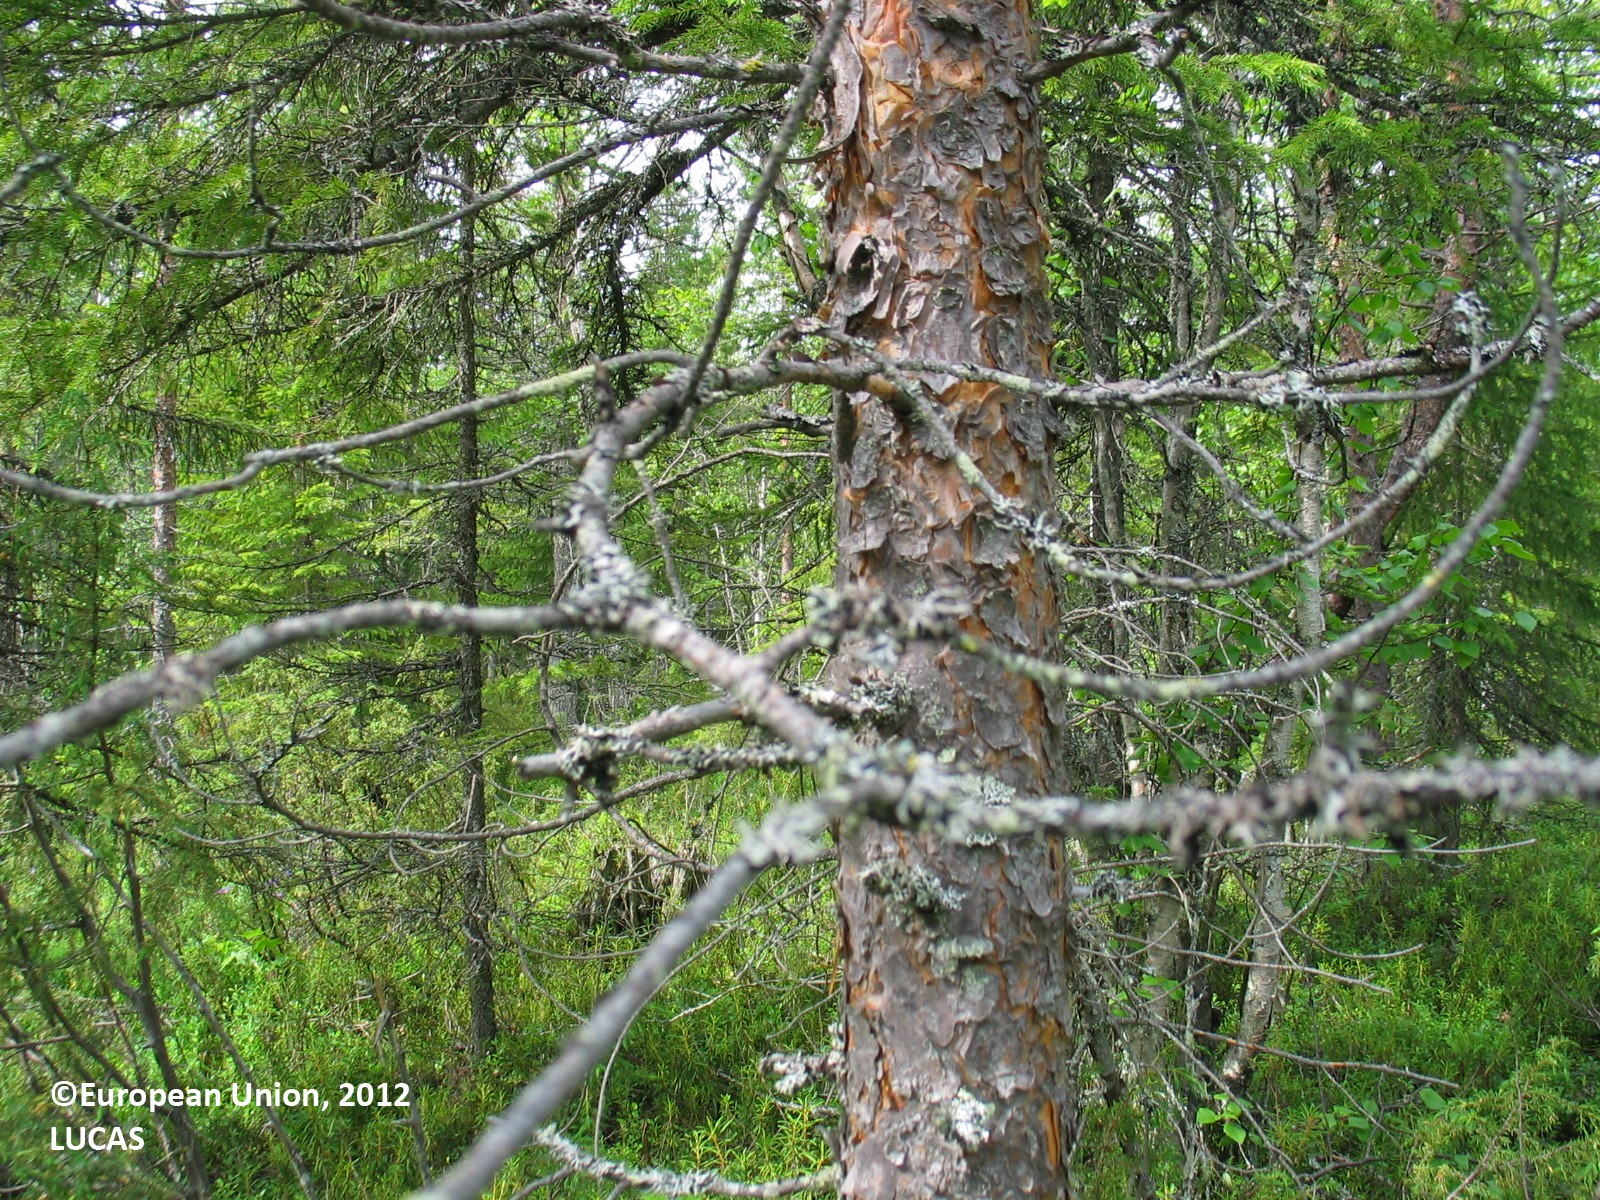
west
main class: Woodland
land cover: Other mixed woodland
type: mire and swamp forests
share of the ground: 25 - 50 %
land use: Forestry
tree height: > 5 m
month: July
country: FI
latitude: 66.0442
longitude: 25.4079
